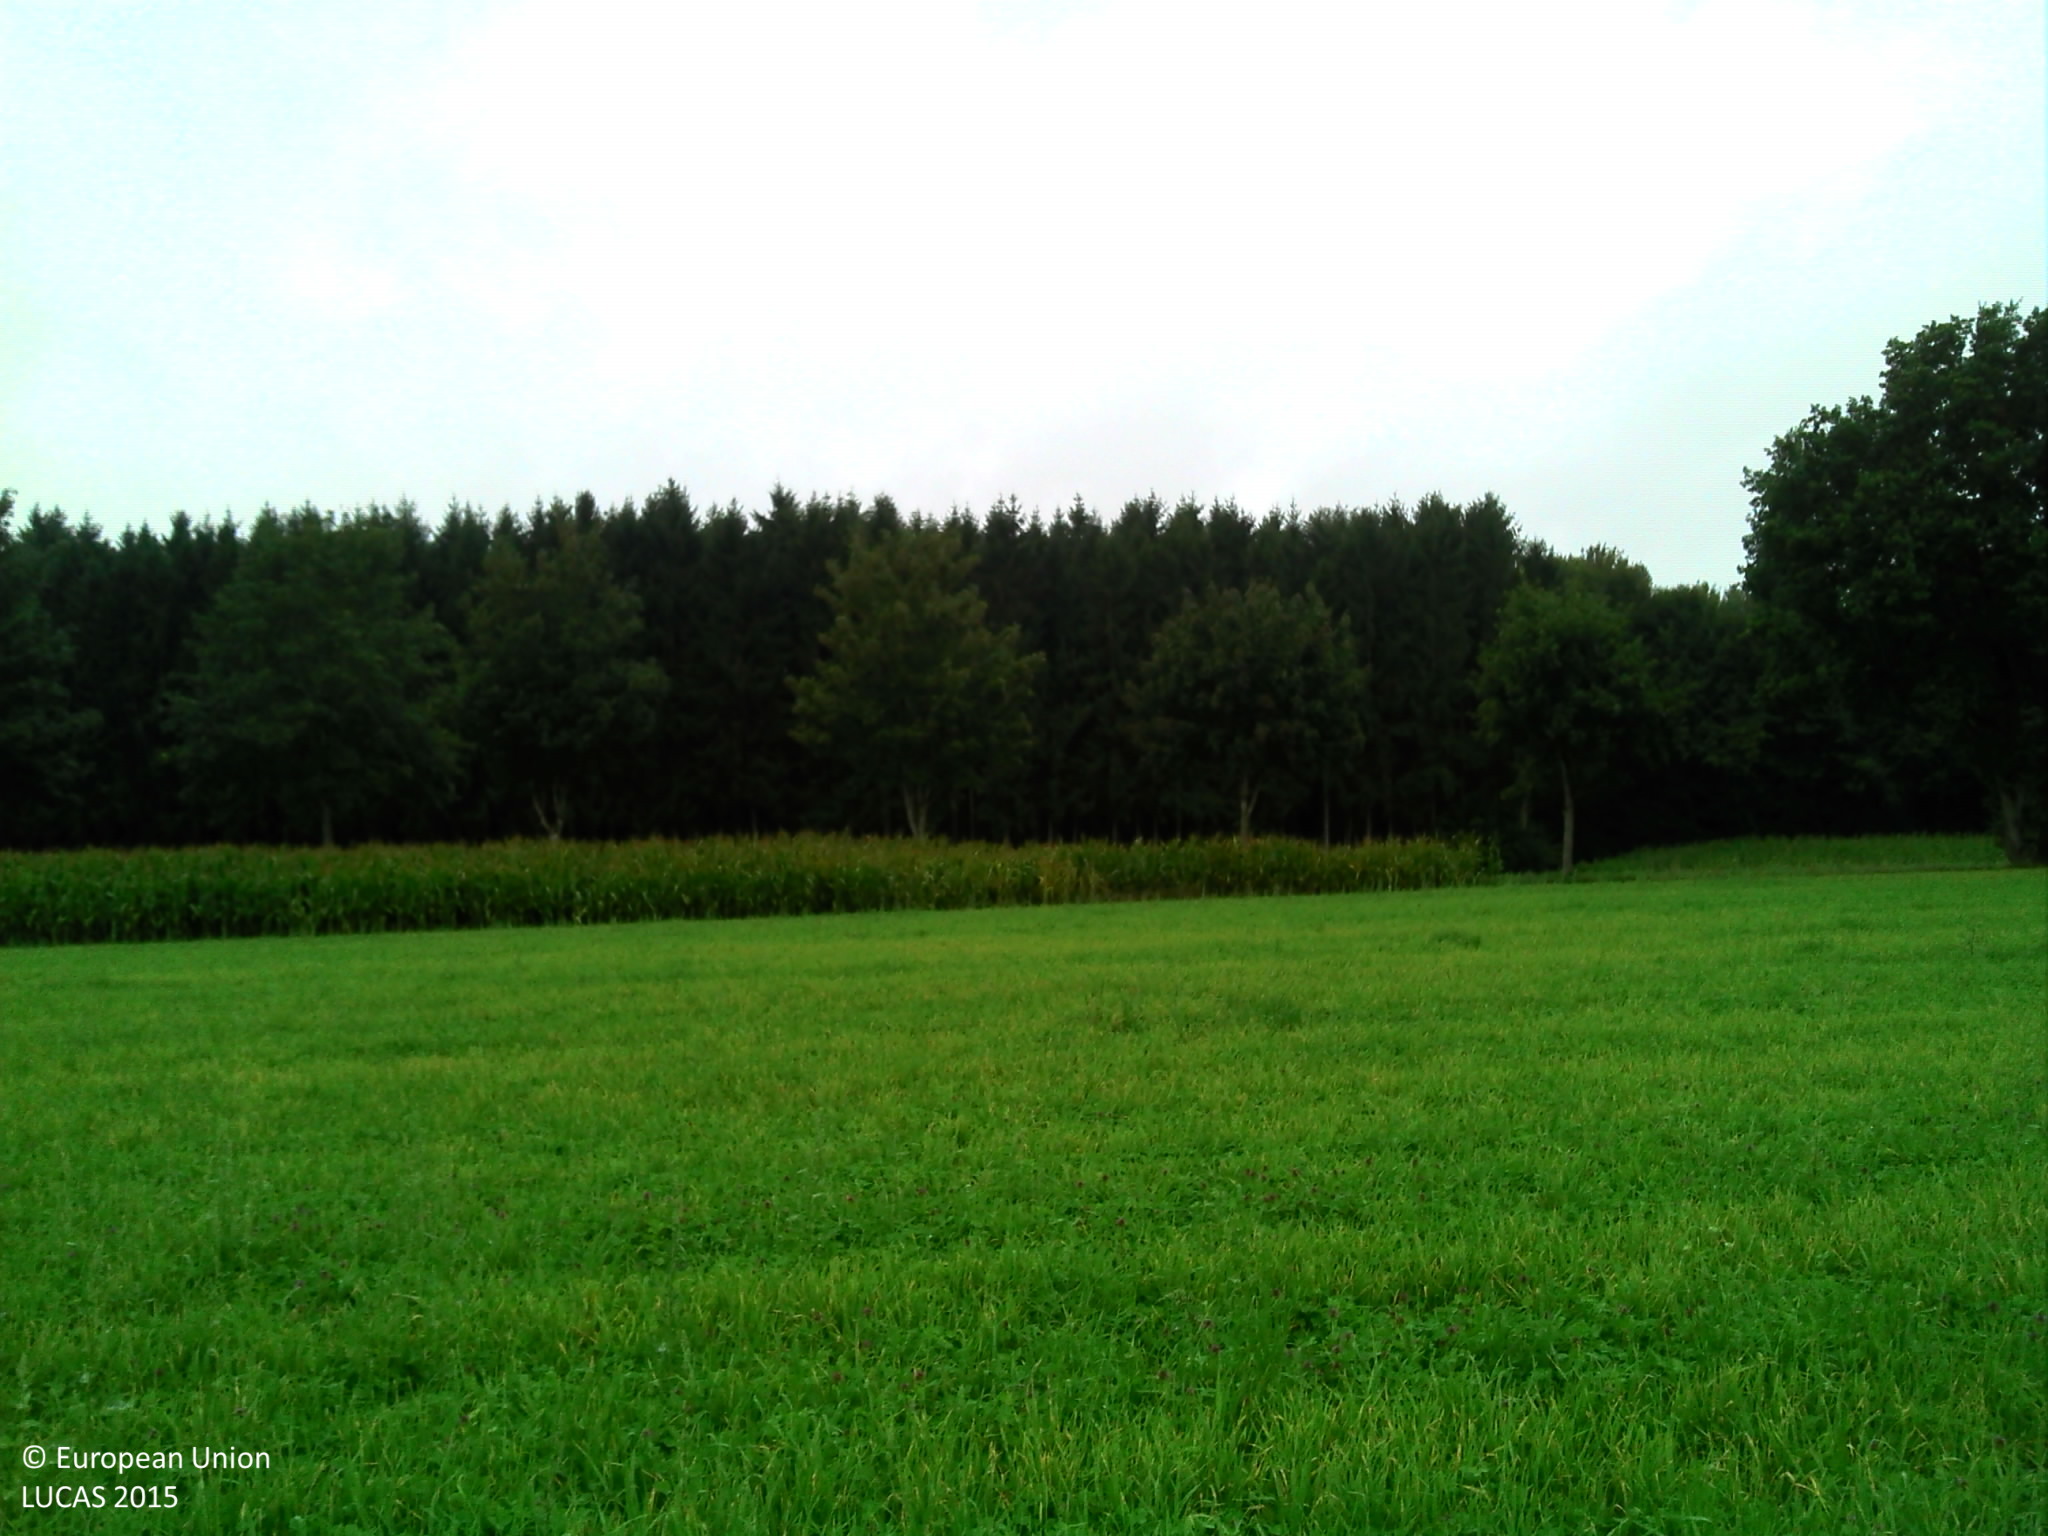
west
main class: Cropland
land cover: Lucerne
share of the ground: > 75 %
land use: Agriculture (excluding fallow land and kitchen gardens)
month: September
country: LU
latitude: 49.7855
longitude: 5.8739
